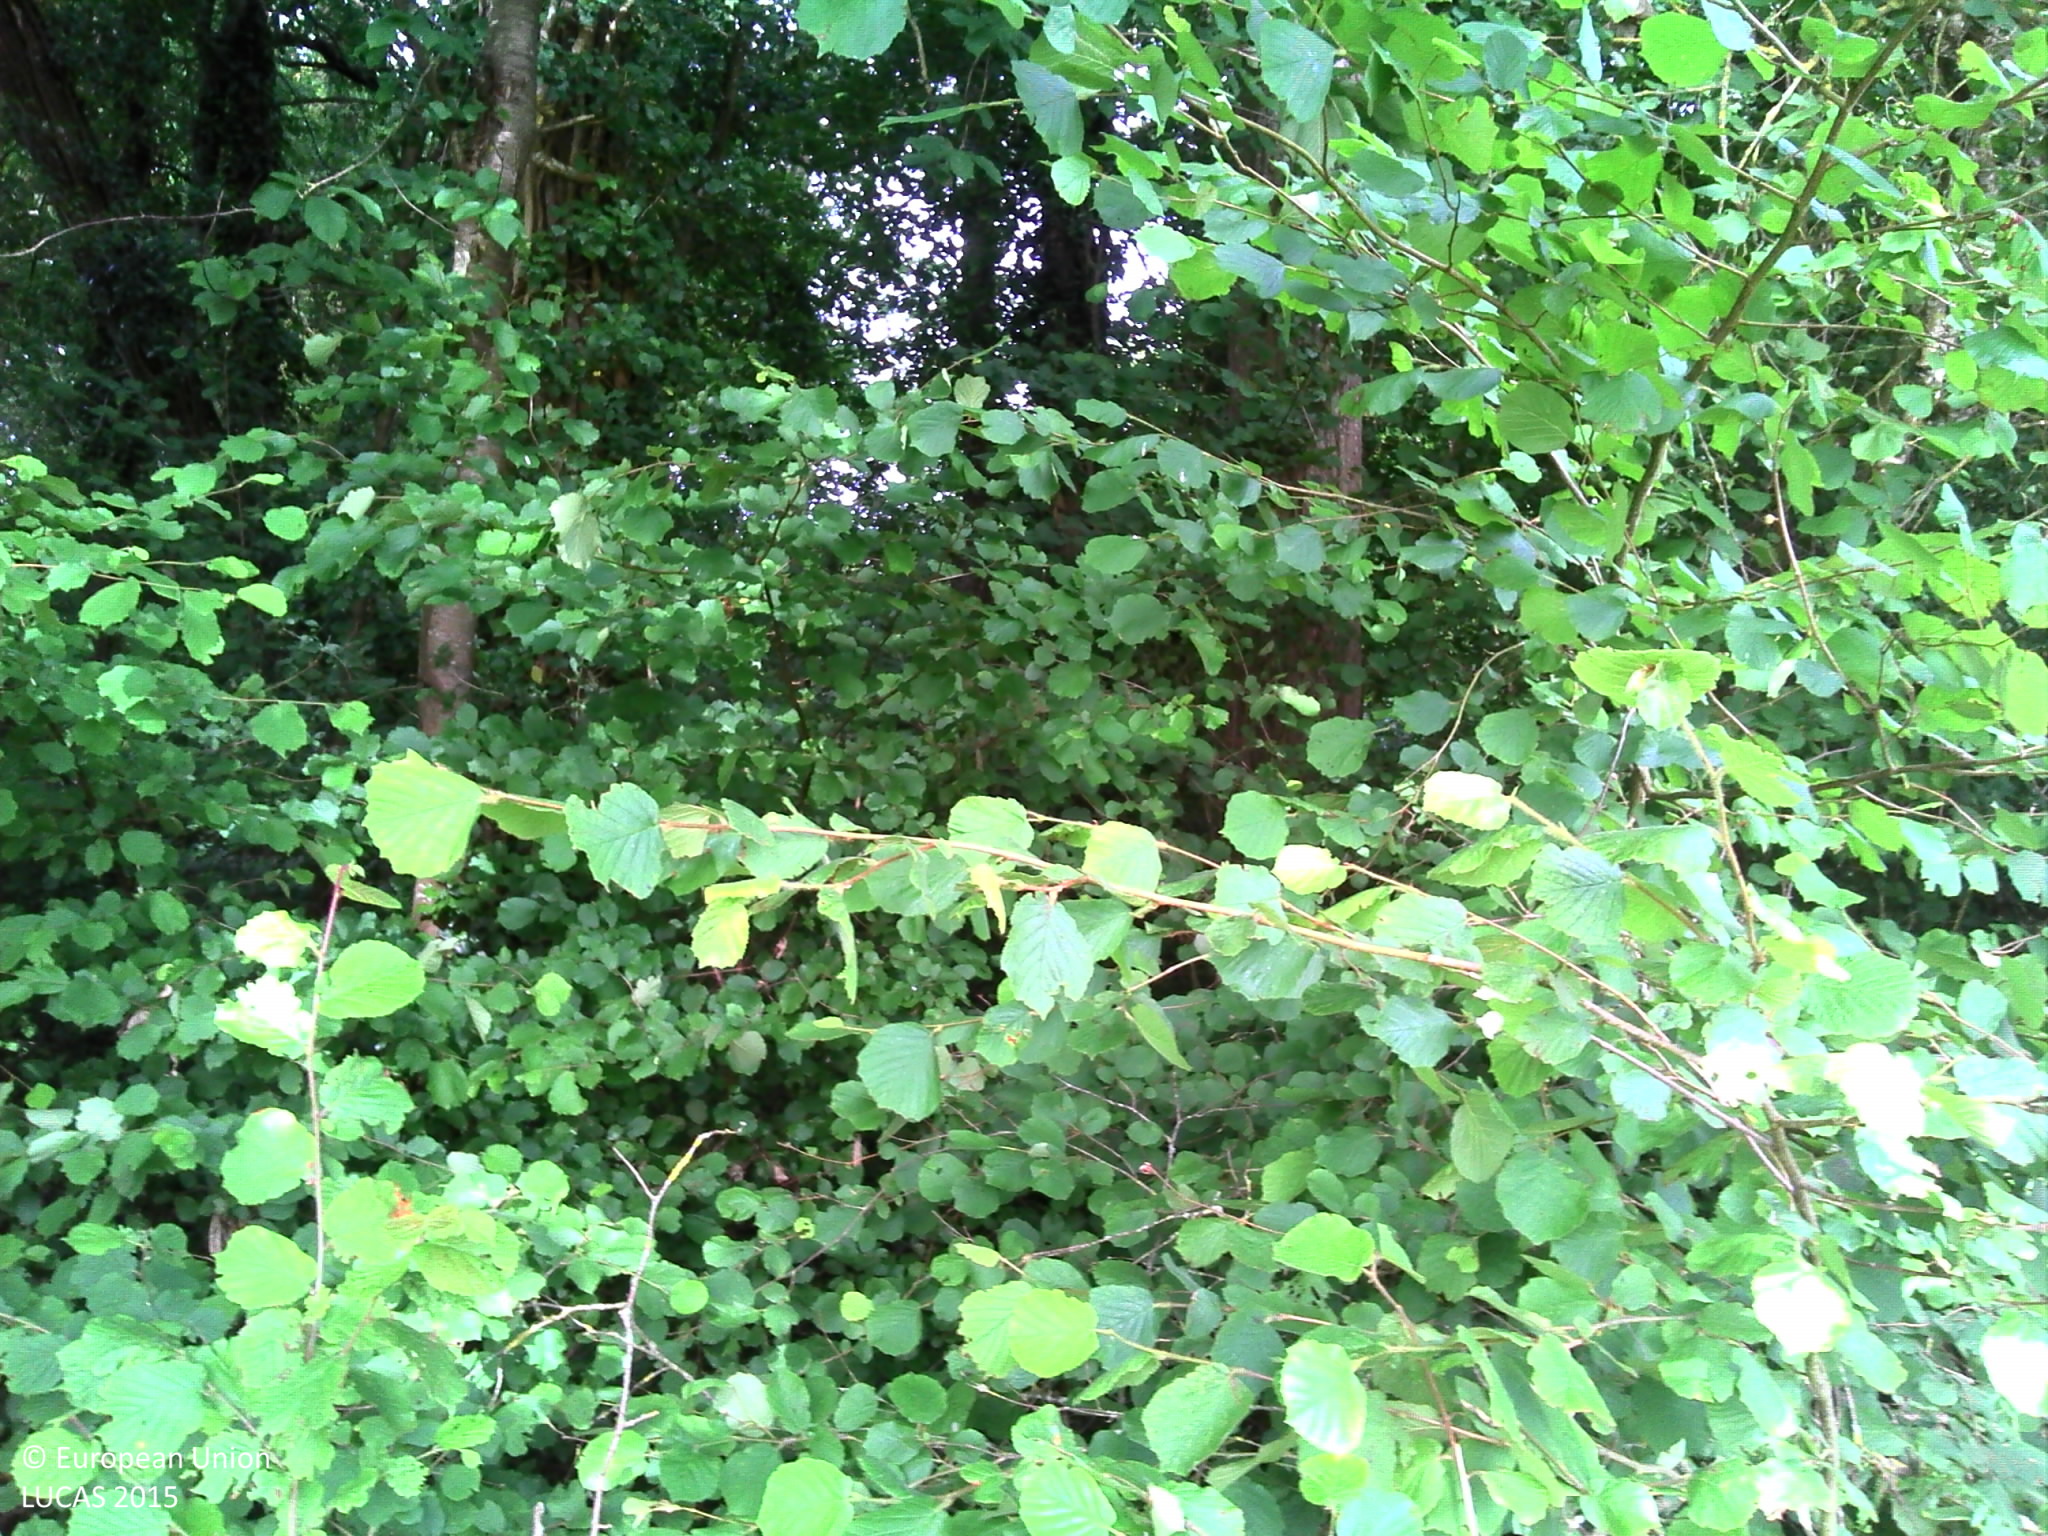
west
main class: Woodland
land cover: Broadleaved woodland
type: acidophilous oak and oak-birch forest
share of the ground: > 75 %
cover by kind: broadleaved forest trees 70 %, shrubs 15 %, herbaceous plants 15 %
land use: Forestry
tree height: > 5 m
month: June
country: FR
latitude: 48.3493
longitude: 0.2170
